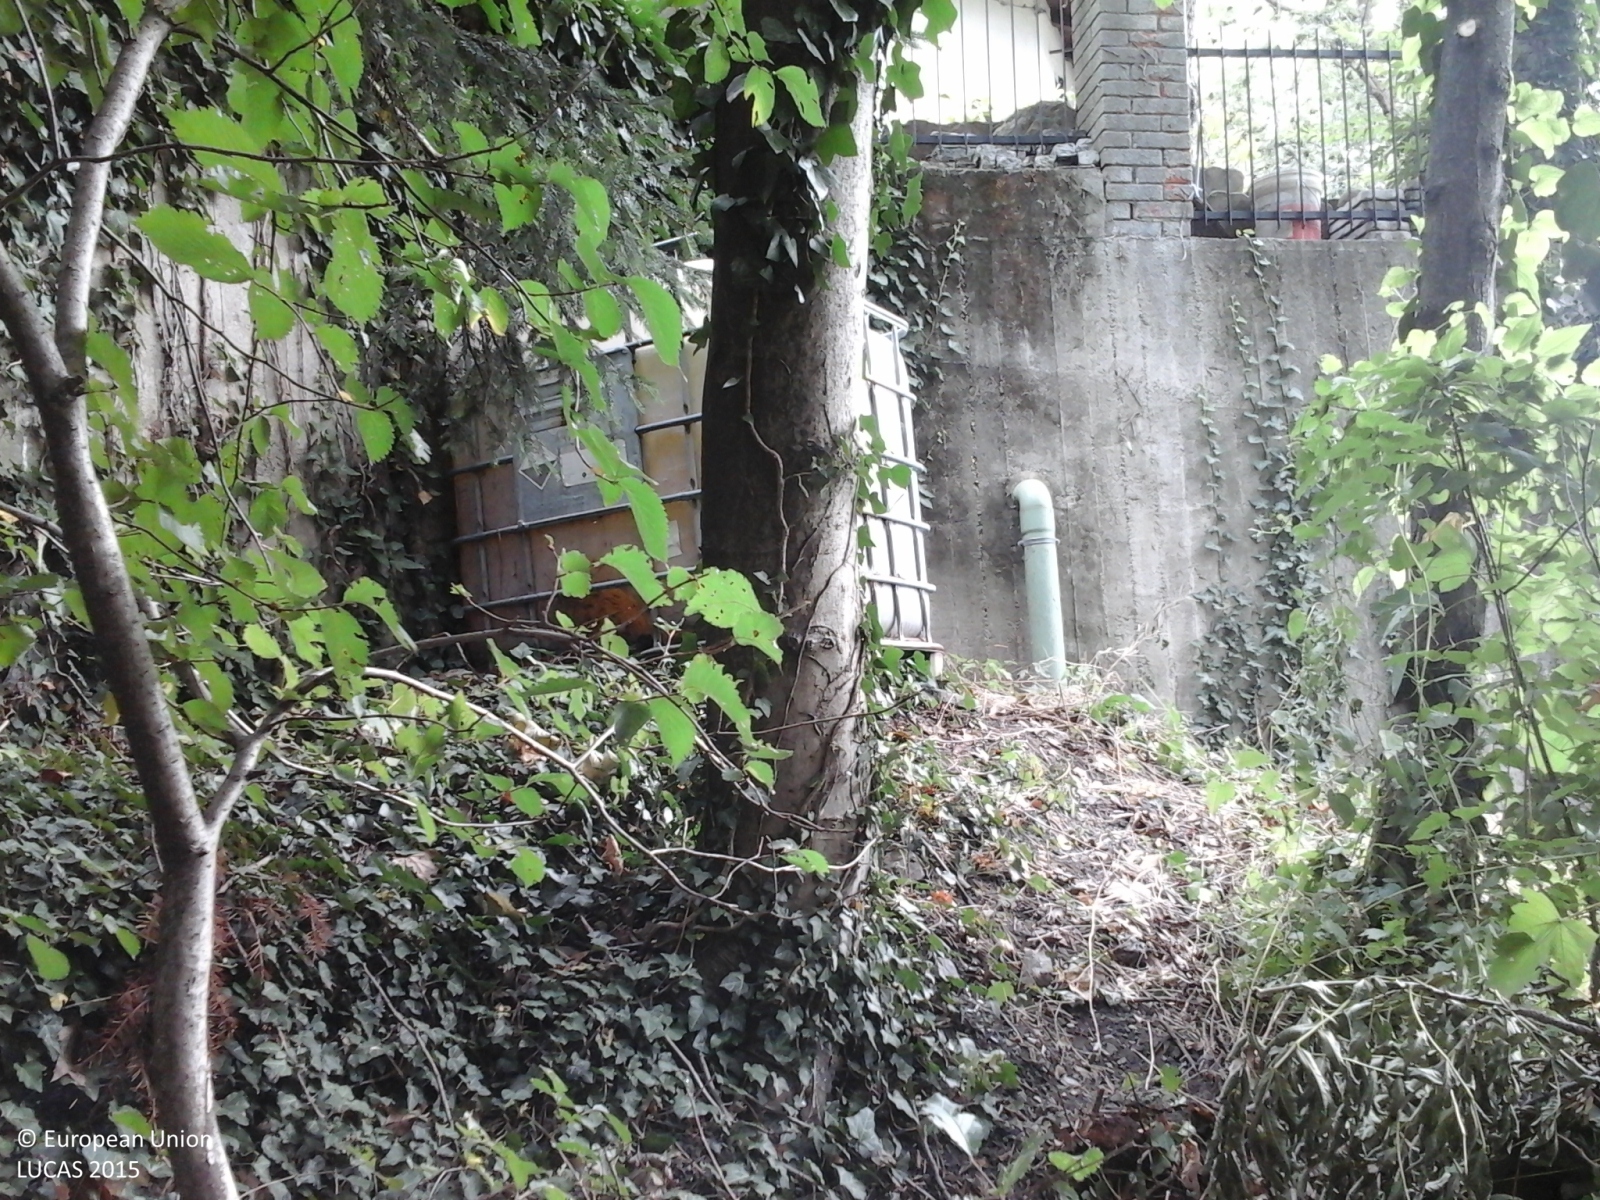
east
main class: Woodland
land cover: Broadleaved woodland
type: thermophilous deciduous forest
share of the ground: > 75 %
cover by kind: broadleaved forest trees 100 %
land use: Forestry
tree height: > 5 m
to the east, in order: Broadleaved woodland; Artificial constructions in urban areas; Broadleaved woodland; Rivers and streams; Broadleaved woodland
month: July
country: IT
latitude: 44.9451
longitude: 7.2293
